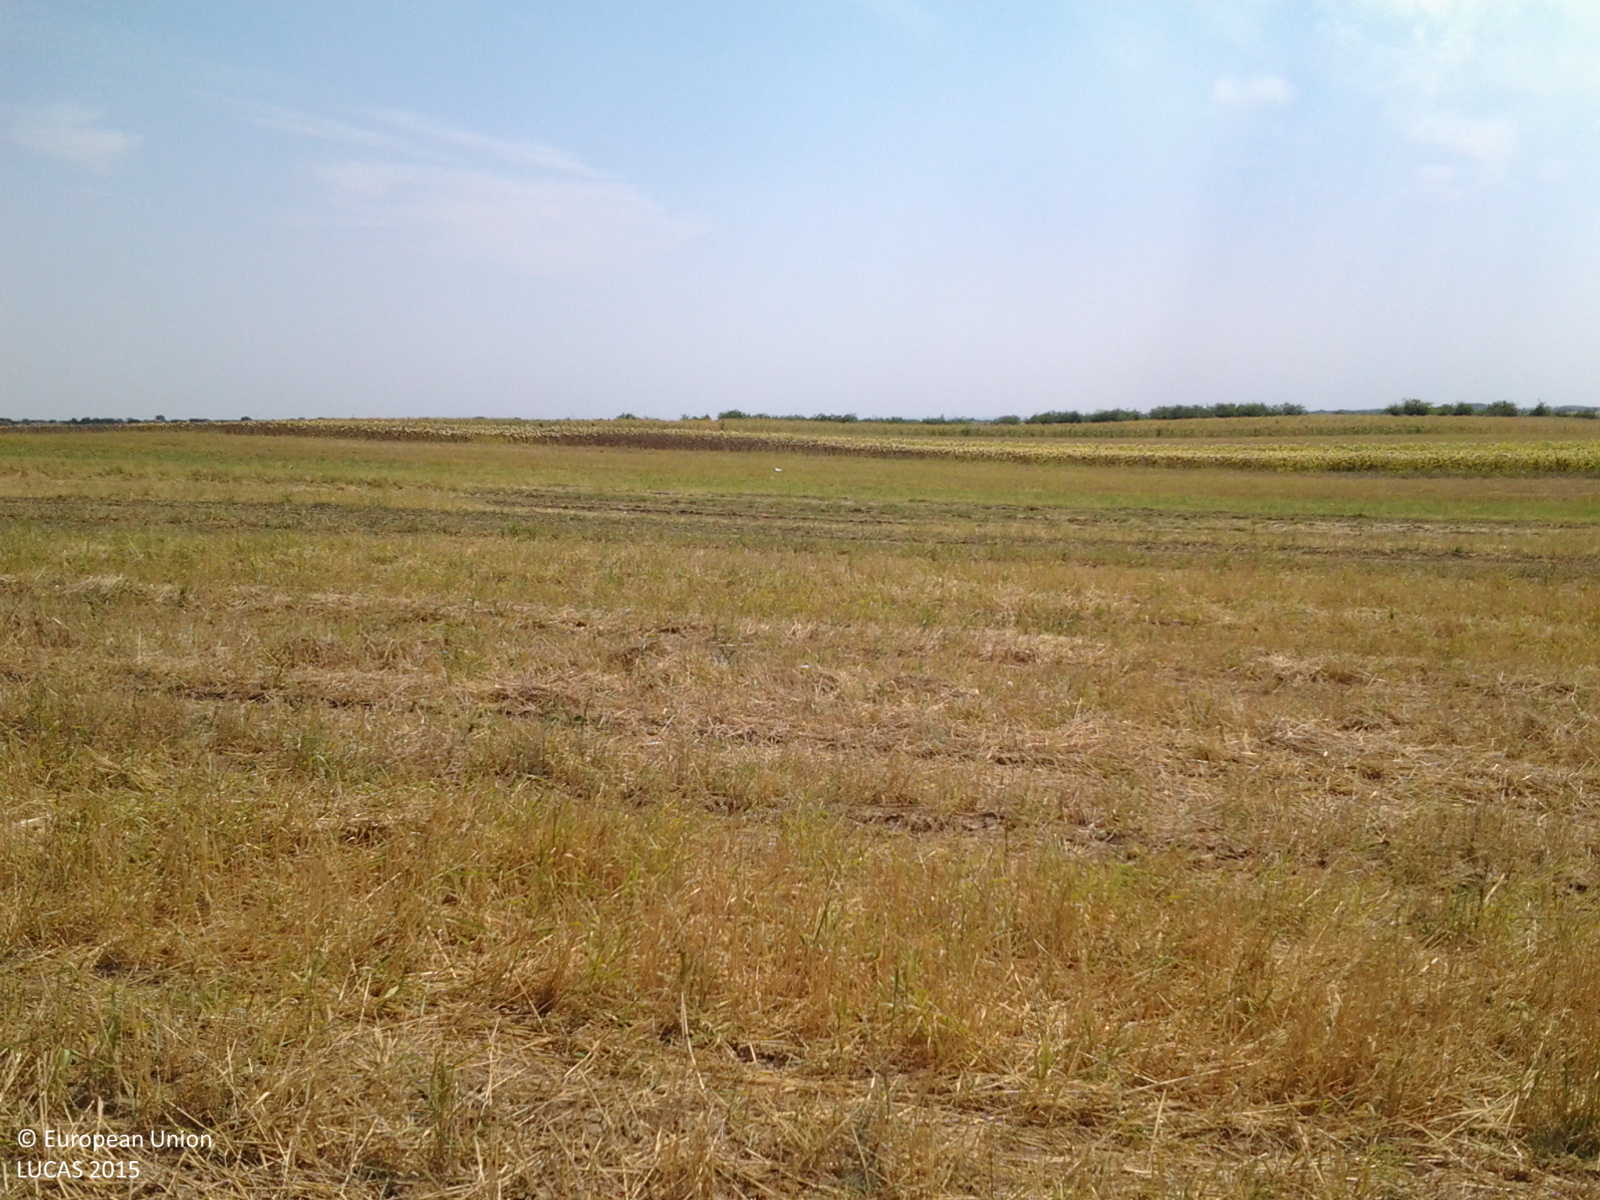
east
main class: Cropland
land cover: Common wheat
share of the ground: > 75 %
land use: Agriculture (excluding fallow land and kitchen gardens)
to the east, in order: Common wheat; Sunflower; Maize; Sunflower; Common wheat
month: August
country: RO
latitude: 43.9032
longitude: 22.9260
